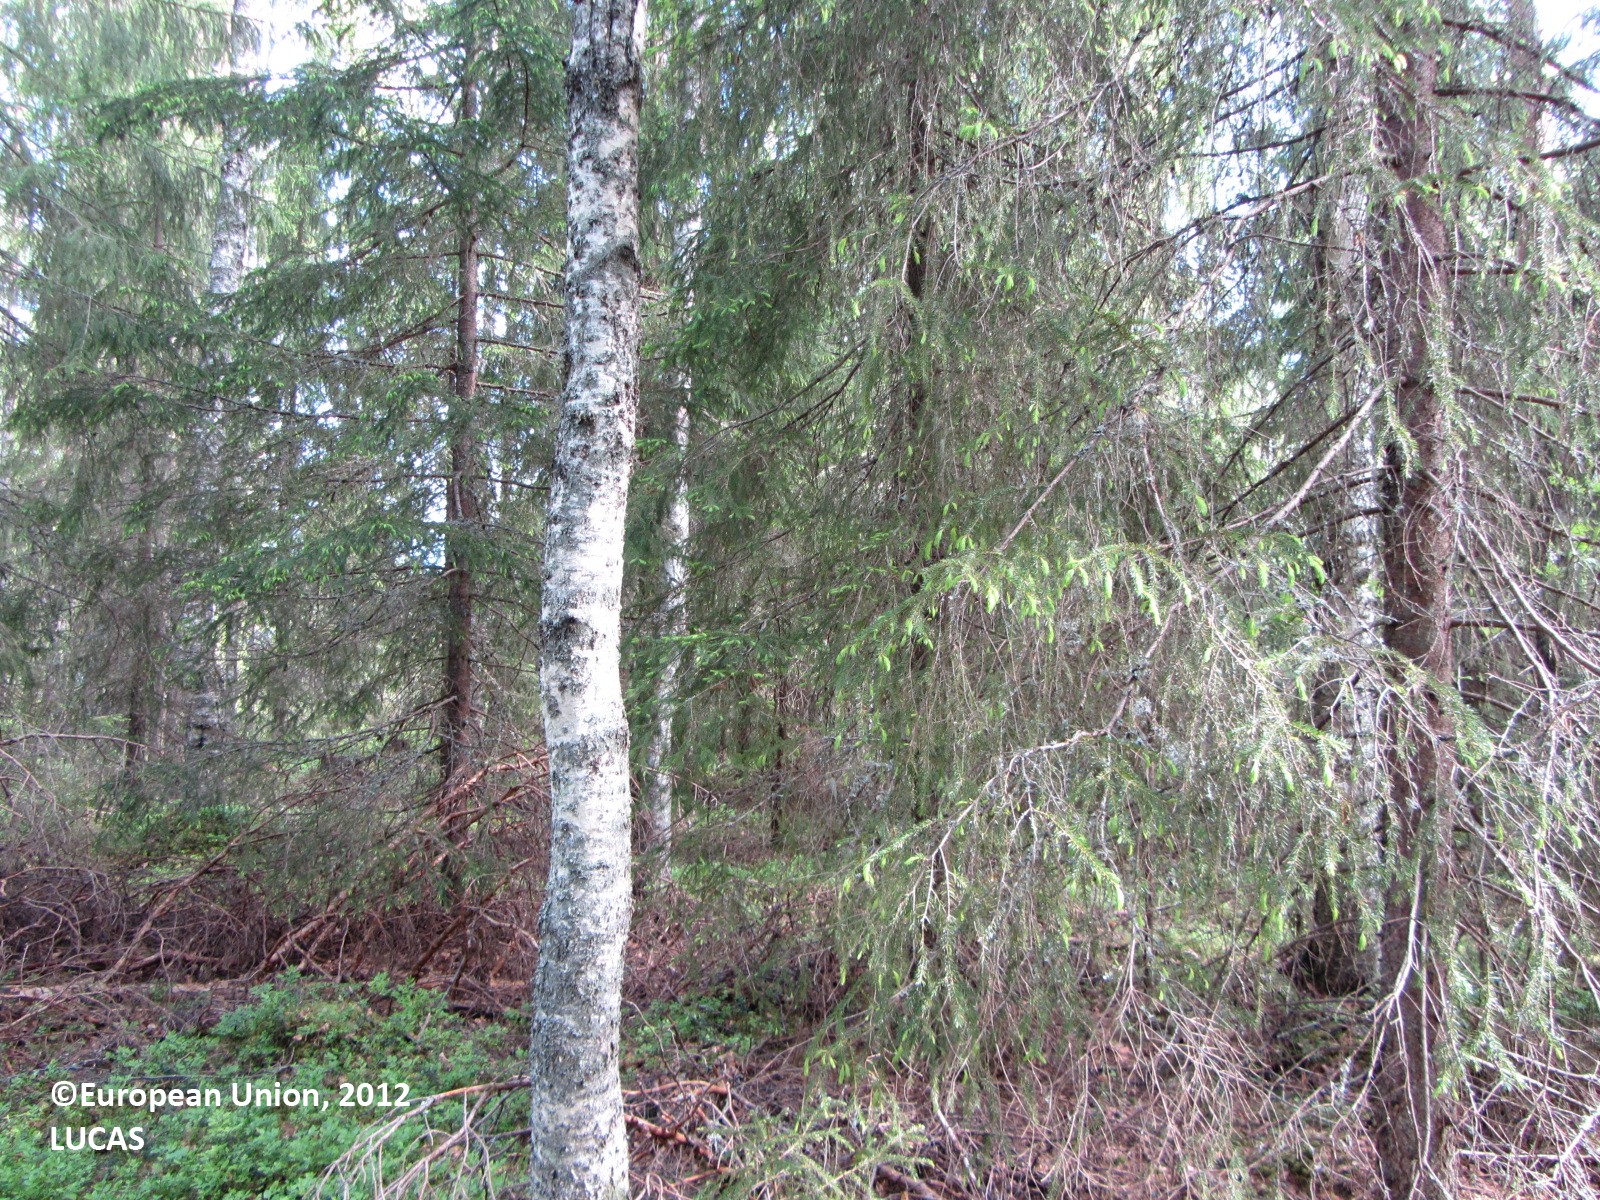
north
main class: Woodland
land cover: Spruce dominated mixed woodland
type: boreal forest
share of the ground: > 75 %
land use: Forestry
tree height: > 5 m
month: June
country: FI
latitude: 61.8034
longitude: 24.9607
